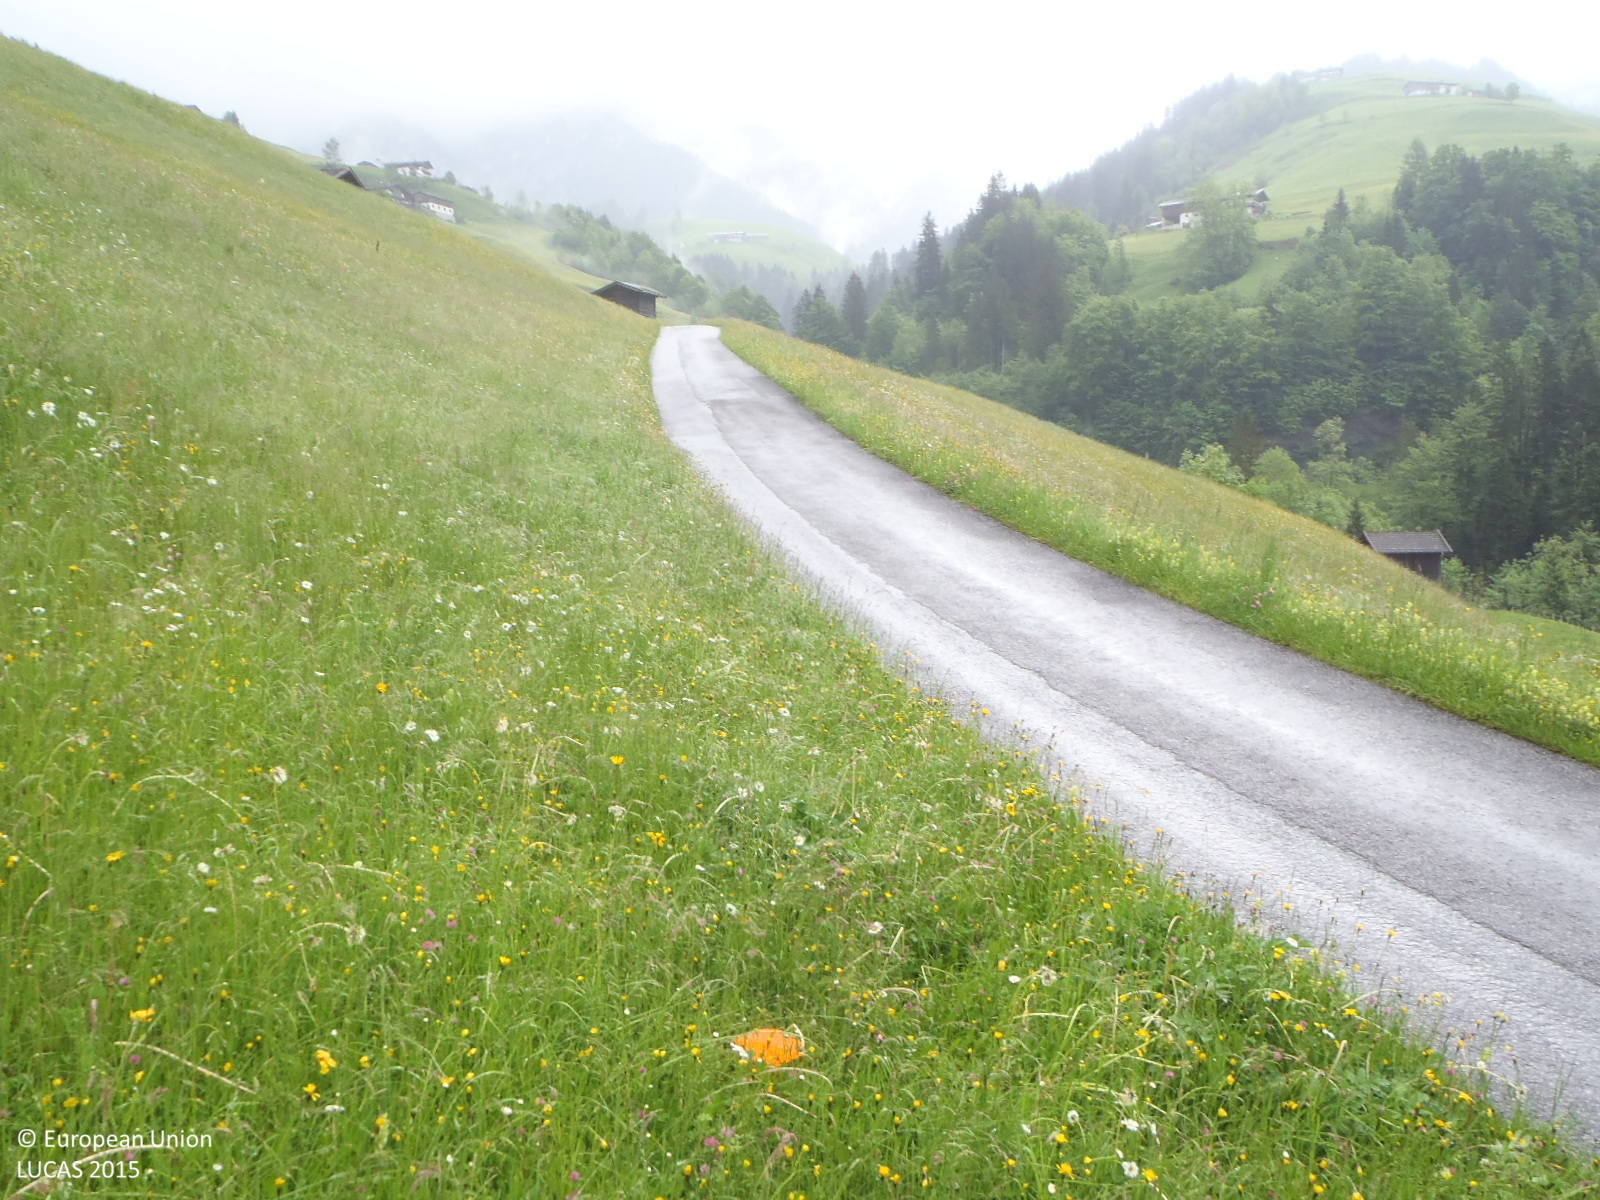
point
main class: Grassland
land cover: Grassland without tree/shrub cover
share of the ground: > 75 %
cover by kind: herbaceous plants 100 %
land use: Agriculture (excluding fallow land and kitchen gardens)
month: May
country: AT
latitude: 47.5590
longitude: 12.7494
